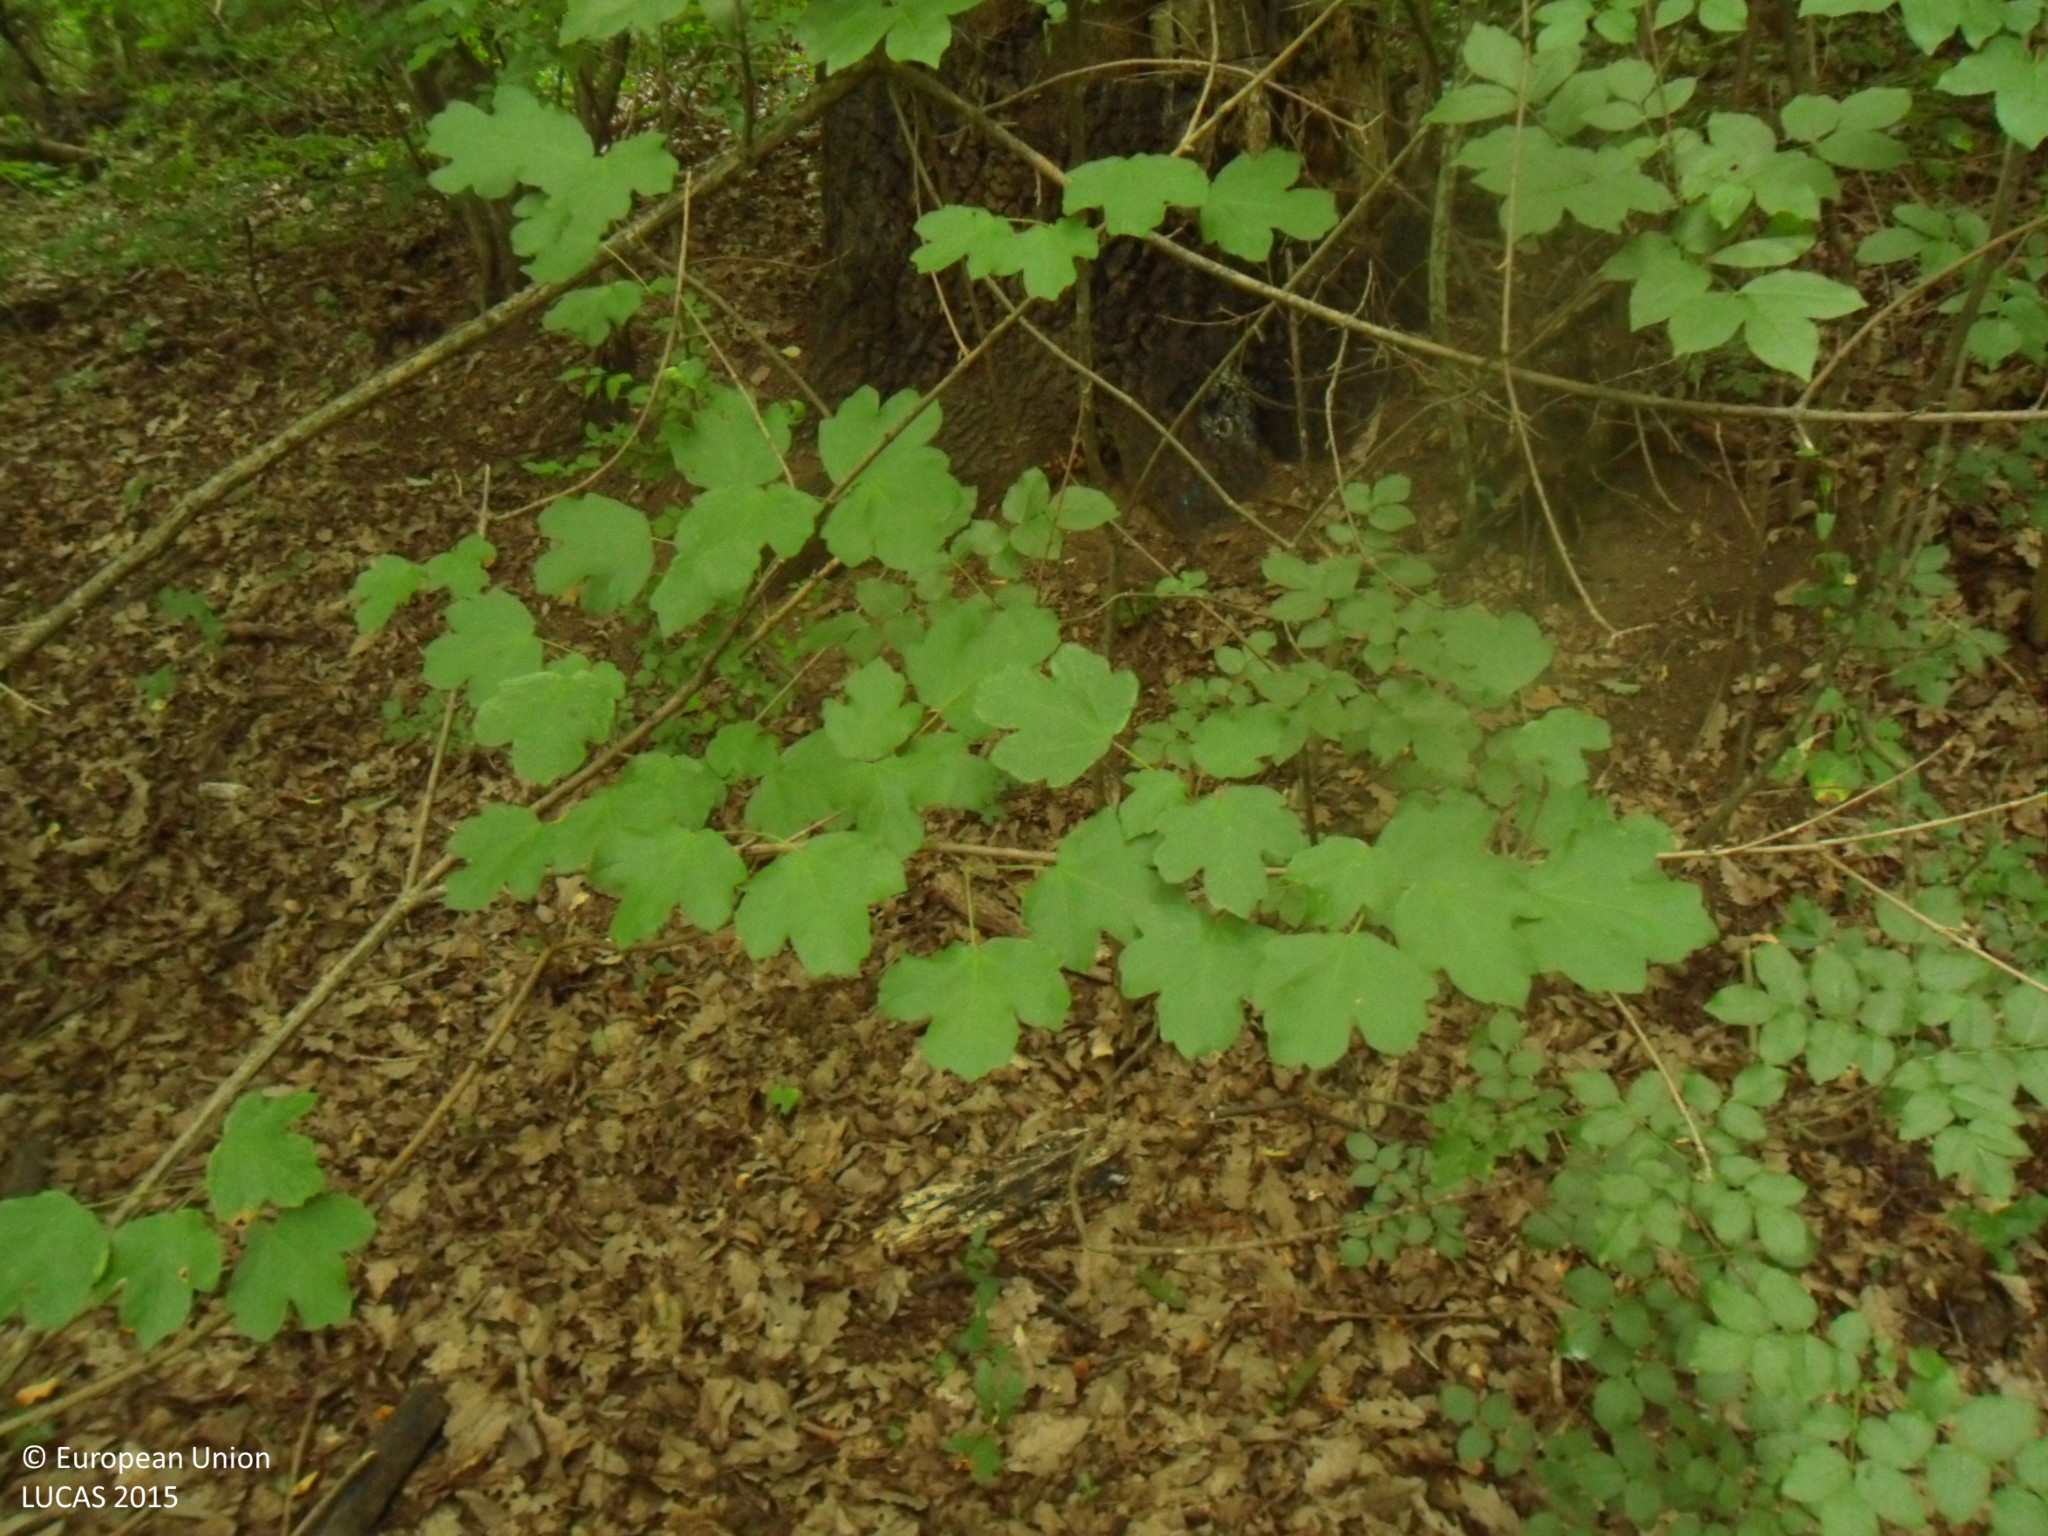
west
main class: Woodland
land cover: Broadleaved woodland
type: mesophytic deciduous forest
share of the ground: > 75 %
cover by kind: broadleaved forest trees 100 %
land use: Forestry
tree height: > 5 m
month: June
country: BG
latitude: 43.0943
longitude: 26.9294
